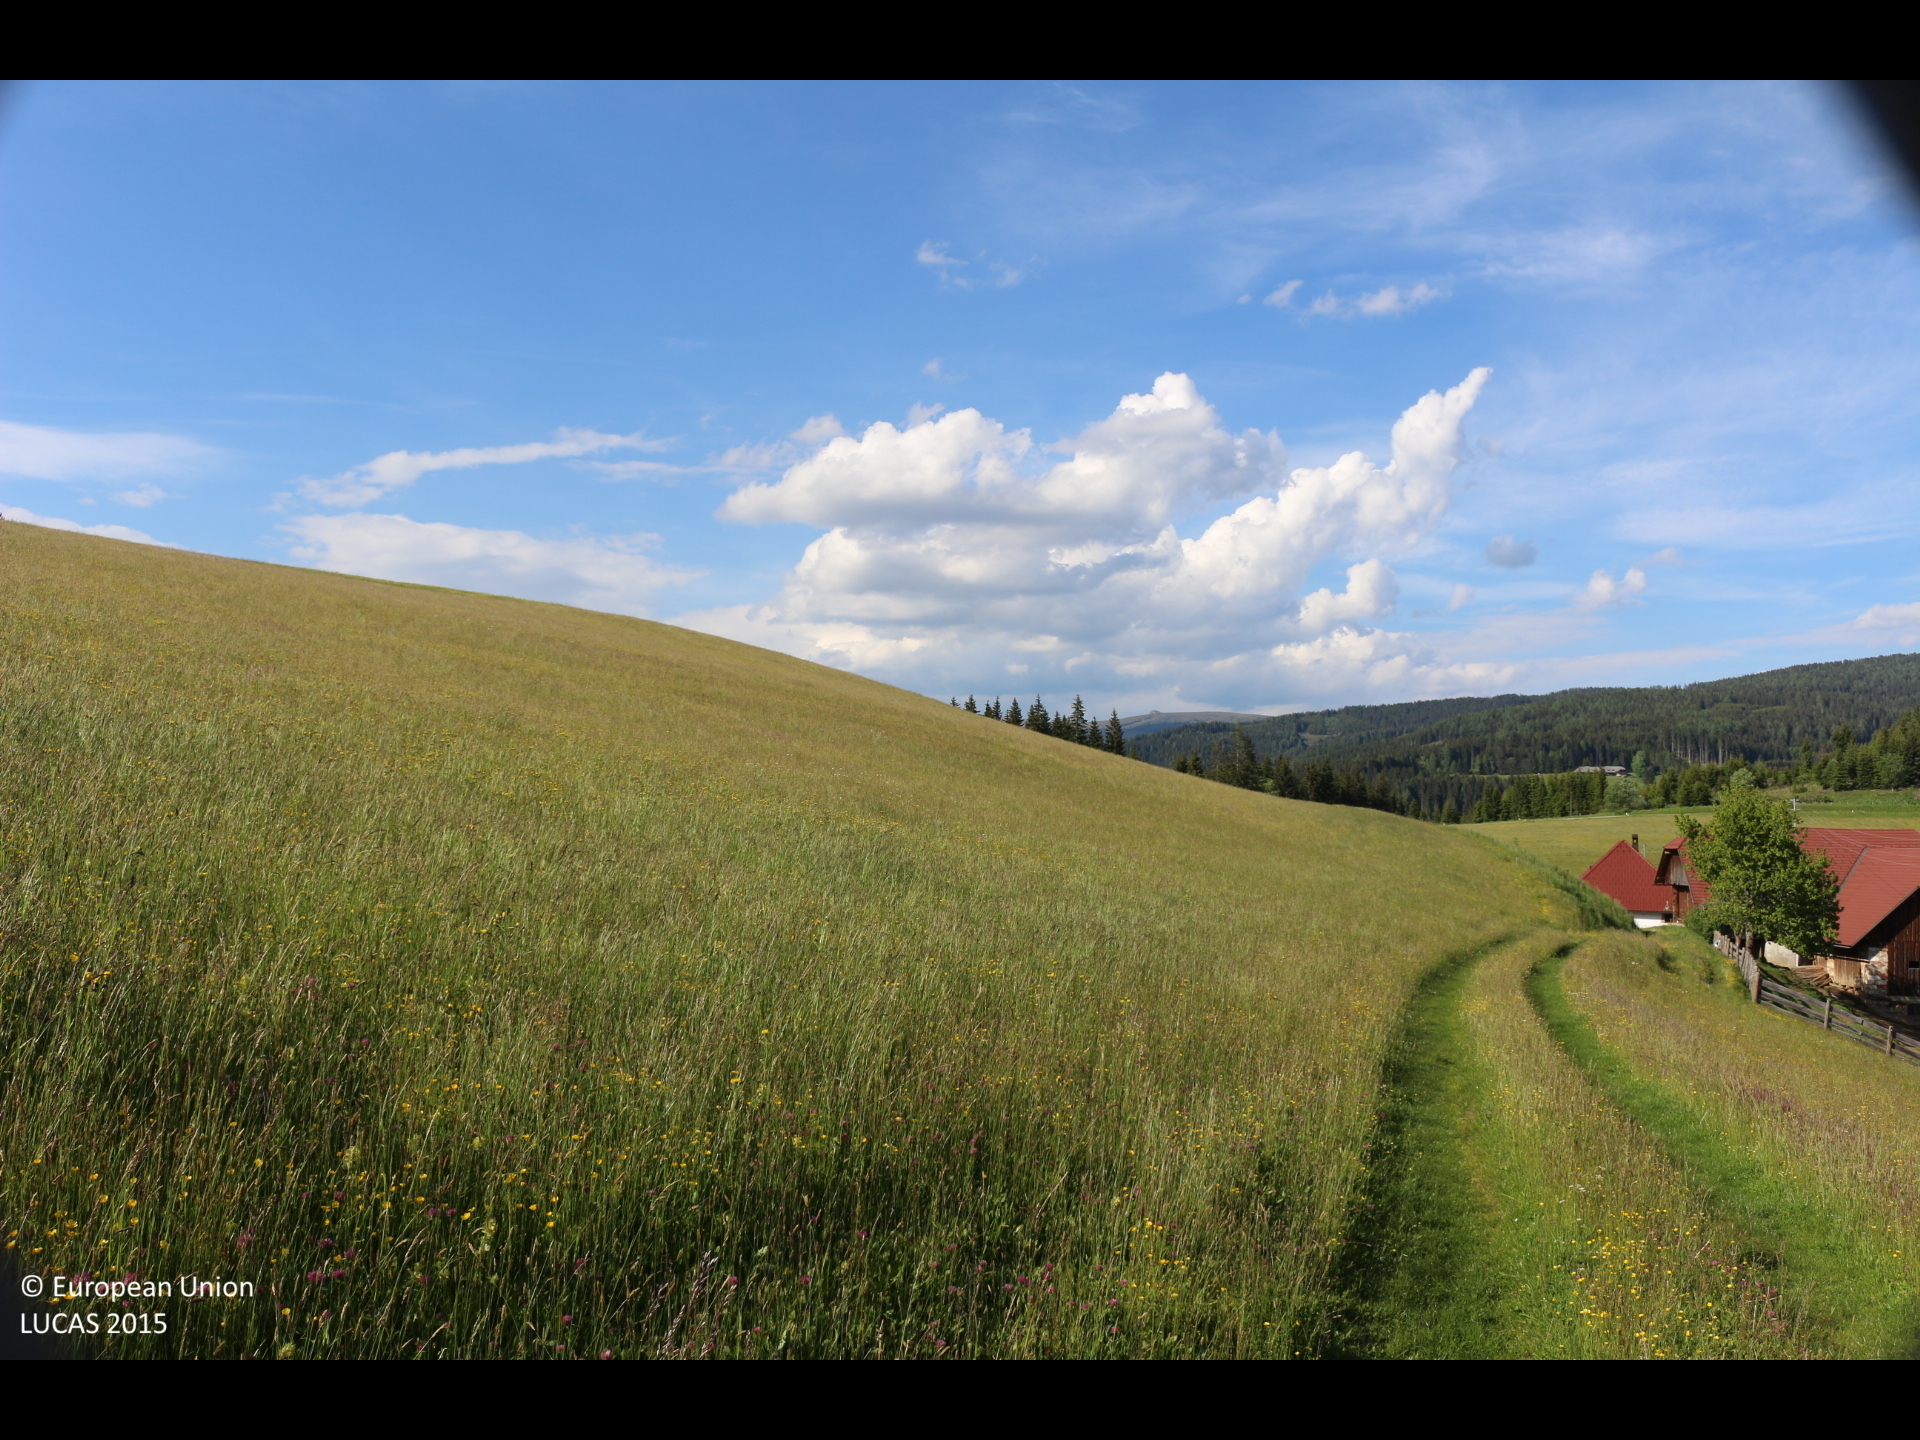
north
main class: Grassland
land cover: Grassland without tree/shrub cover
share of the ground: > 75 %
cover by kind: herbaceous plants 100 %
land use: Agriculture (excluding fallow land and kitchen gardens)
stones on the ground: < 10 %
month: May
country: AT
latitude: 46.7576
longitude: 14.5933
